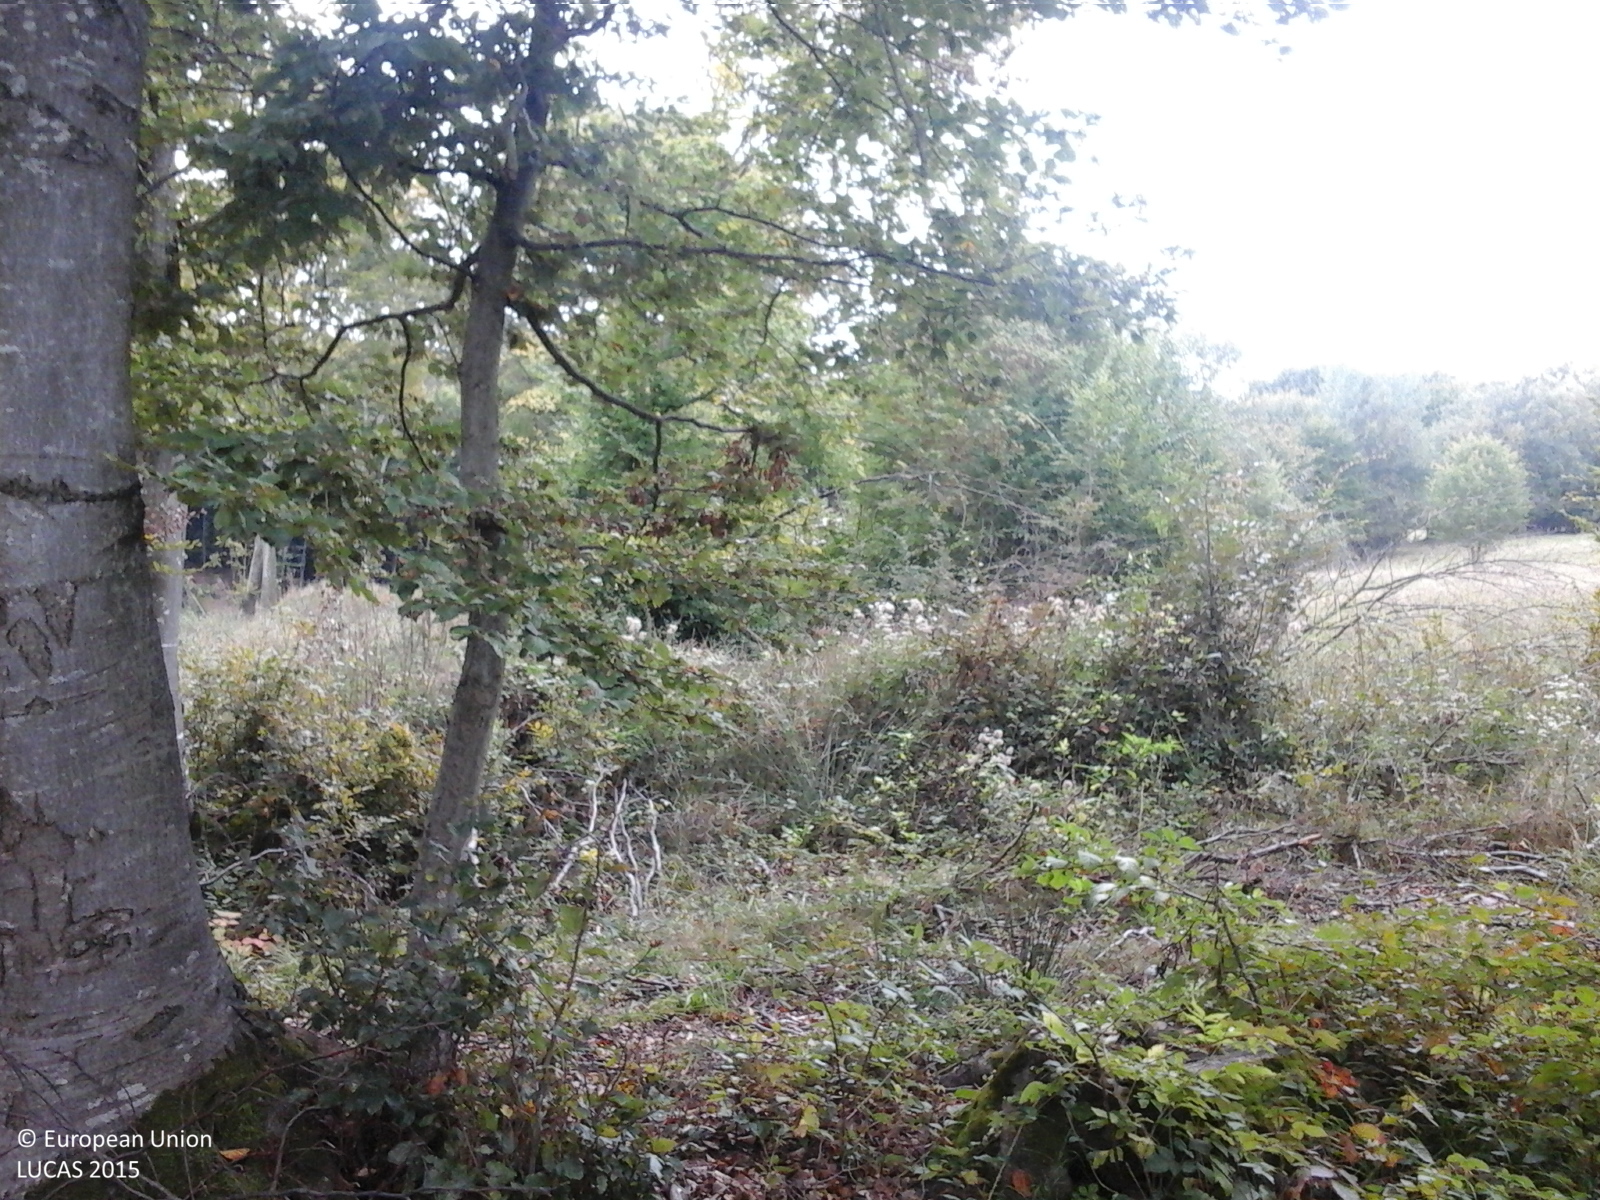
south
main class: Woodland
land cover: Broadleaved woodland
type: beech forest
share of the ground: > 75 %
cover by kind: broadleaved forest trees 100 %
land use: Forestry
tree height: > 5 m
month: October
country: RO
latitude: 46.3901
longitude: 24.9594
